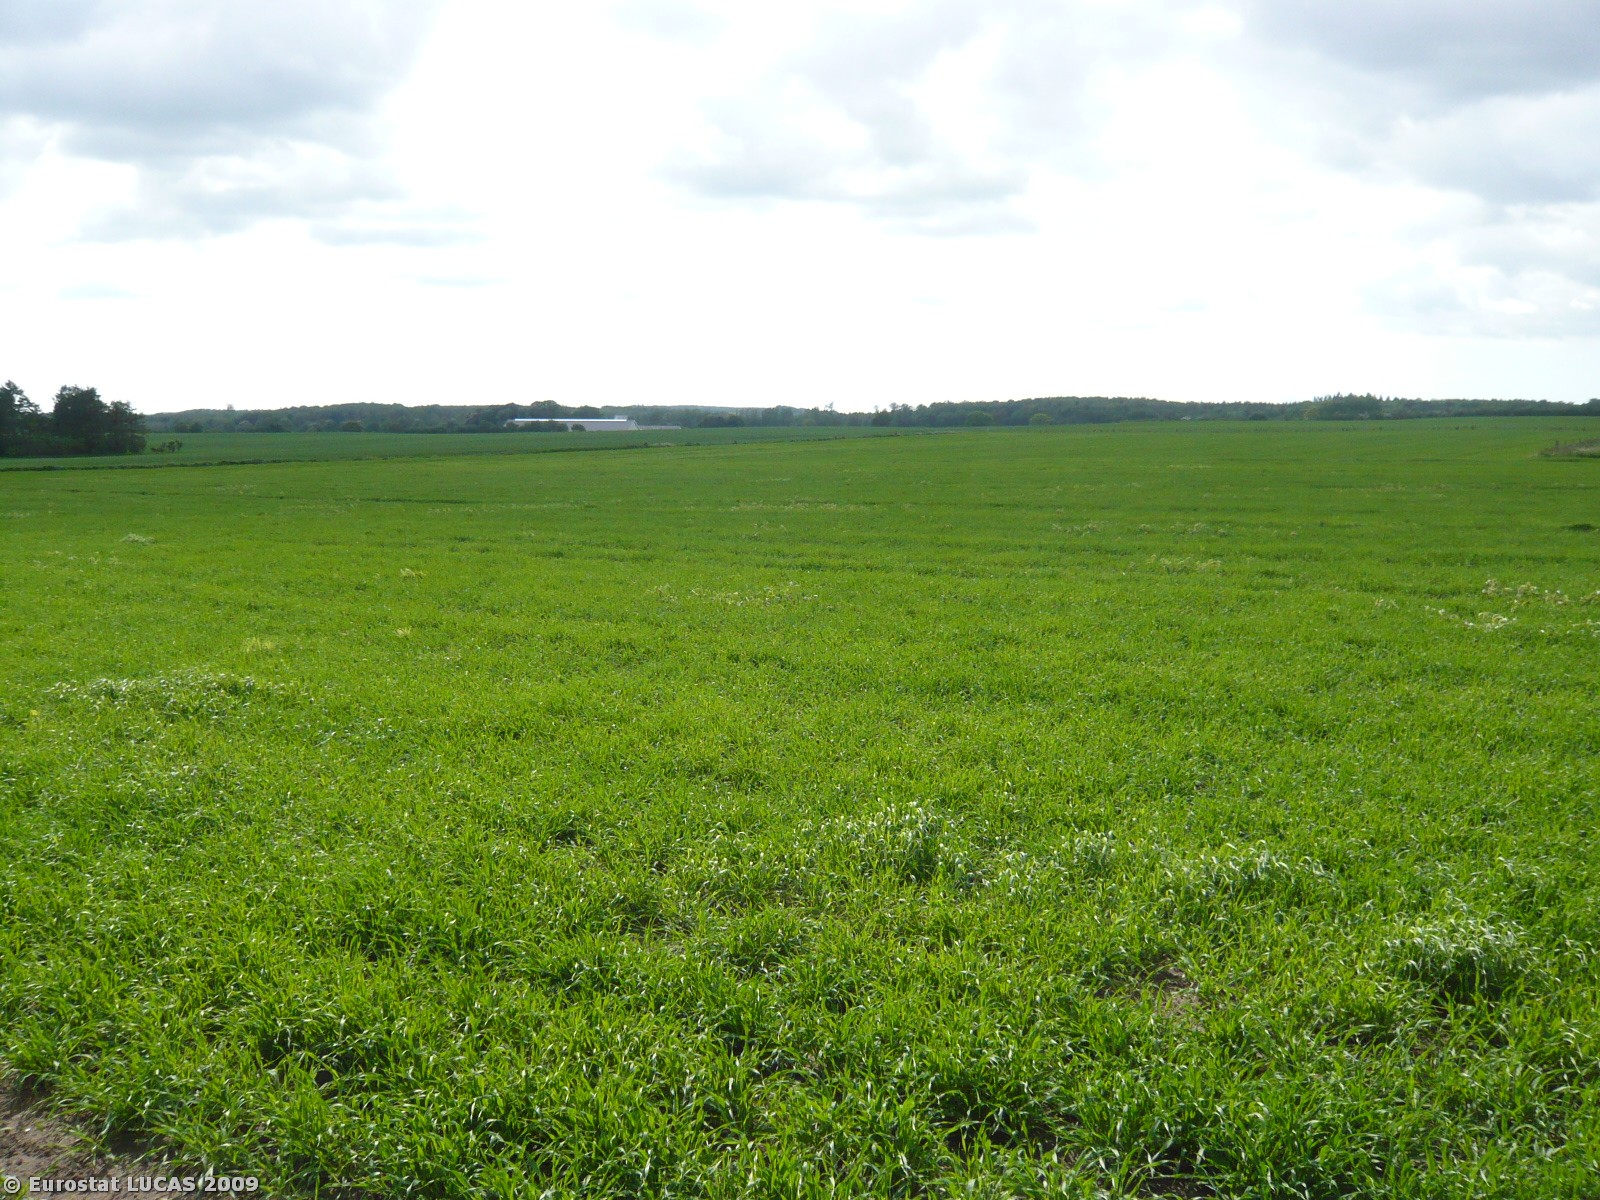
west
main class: Cropland
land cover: Barley
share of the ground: > 75 %
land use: Agriculture (excluding fallow land and kitchen gardens)
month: May
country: DK
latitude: 55.3676
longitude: 11.6868
